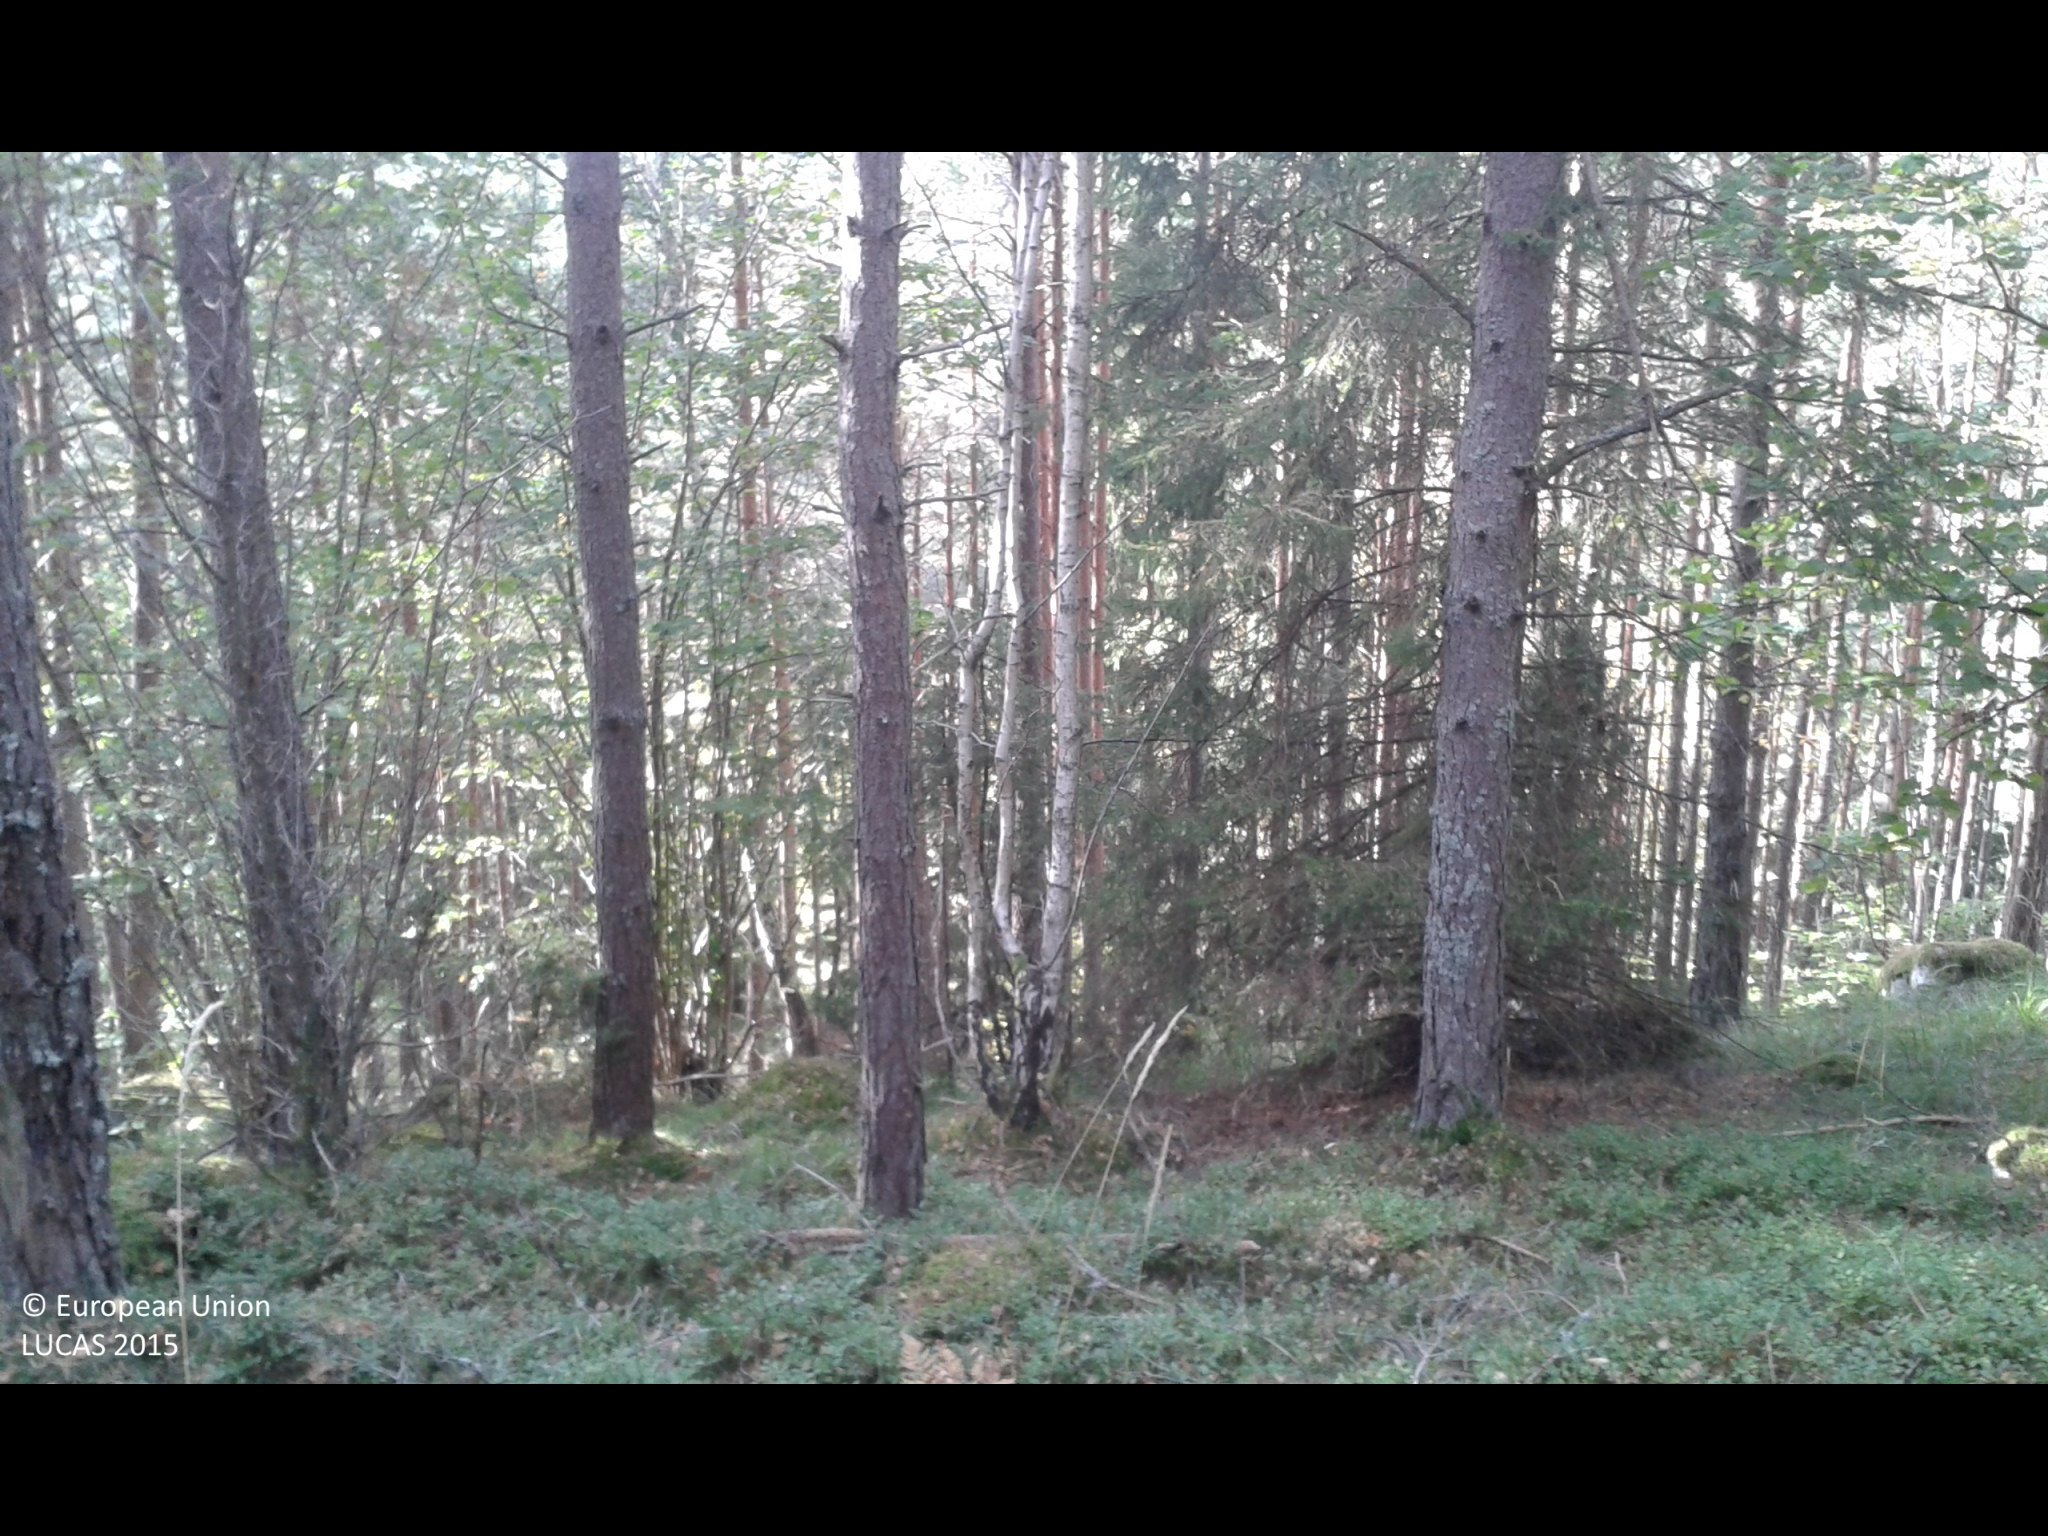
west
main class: Woodland
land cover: Pine dominated coniferous woodland
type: boreal forest
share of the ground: 50 - 75 %
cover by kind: coniferous forest trees 55 %, herbaceous plants 40 %, broadleaved forest trees 5 %
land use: Forestry
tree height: > 5 m
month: October
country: SE
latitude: 58.9223
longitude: 17.3441
